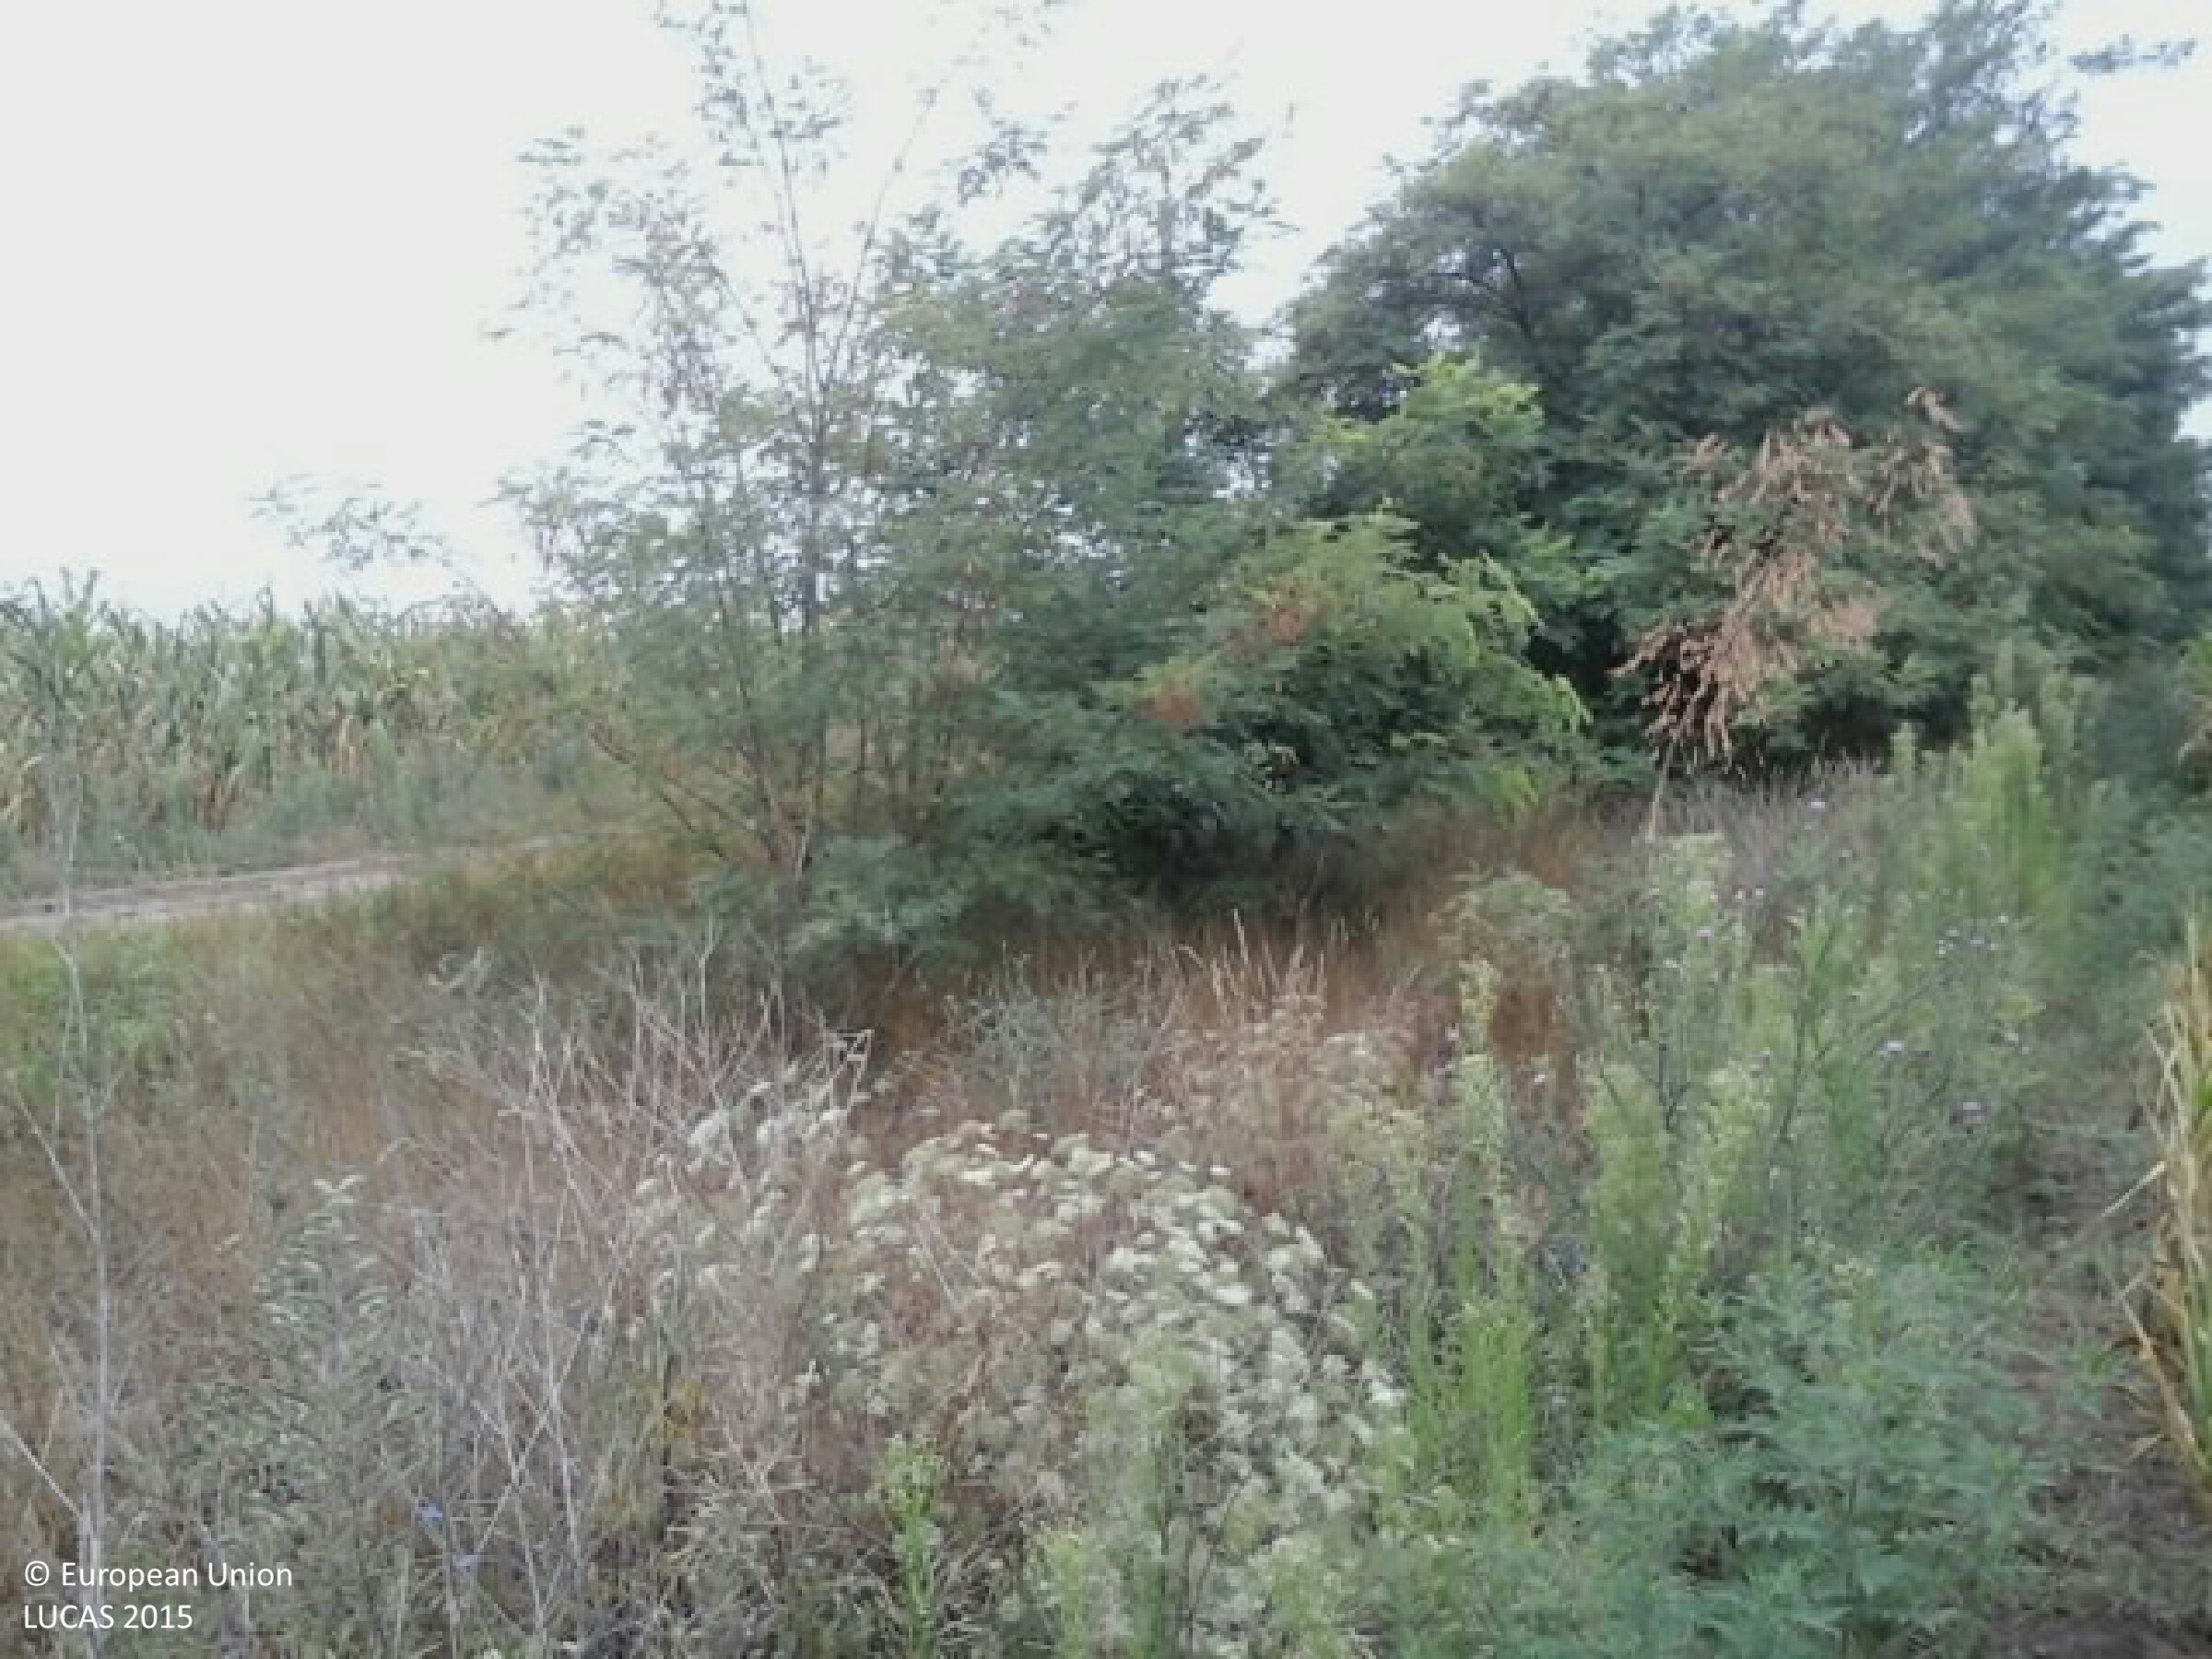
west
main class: Cropland
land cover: Maize
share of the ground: > 75 %
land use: Agriculture (excluding fallow land and kitchen gardens)
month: July
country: HU
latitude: 46.9760
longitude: 19.7358
